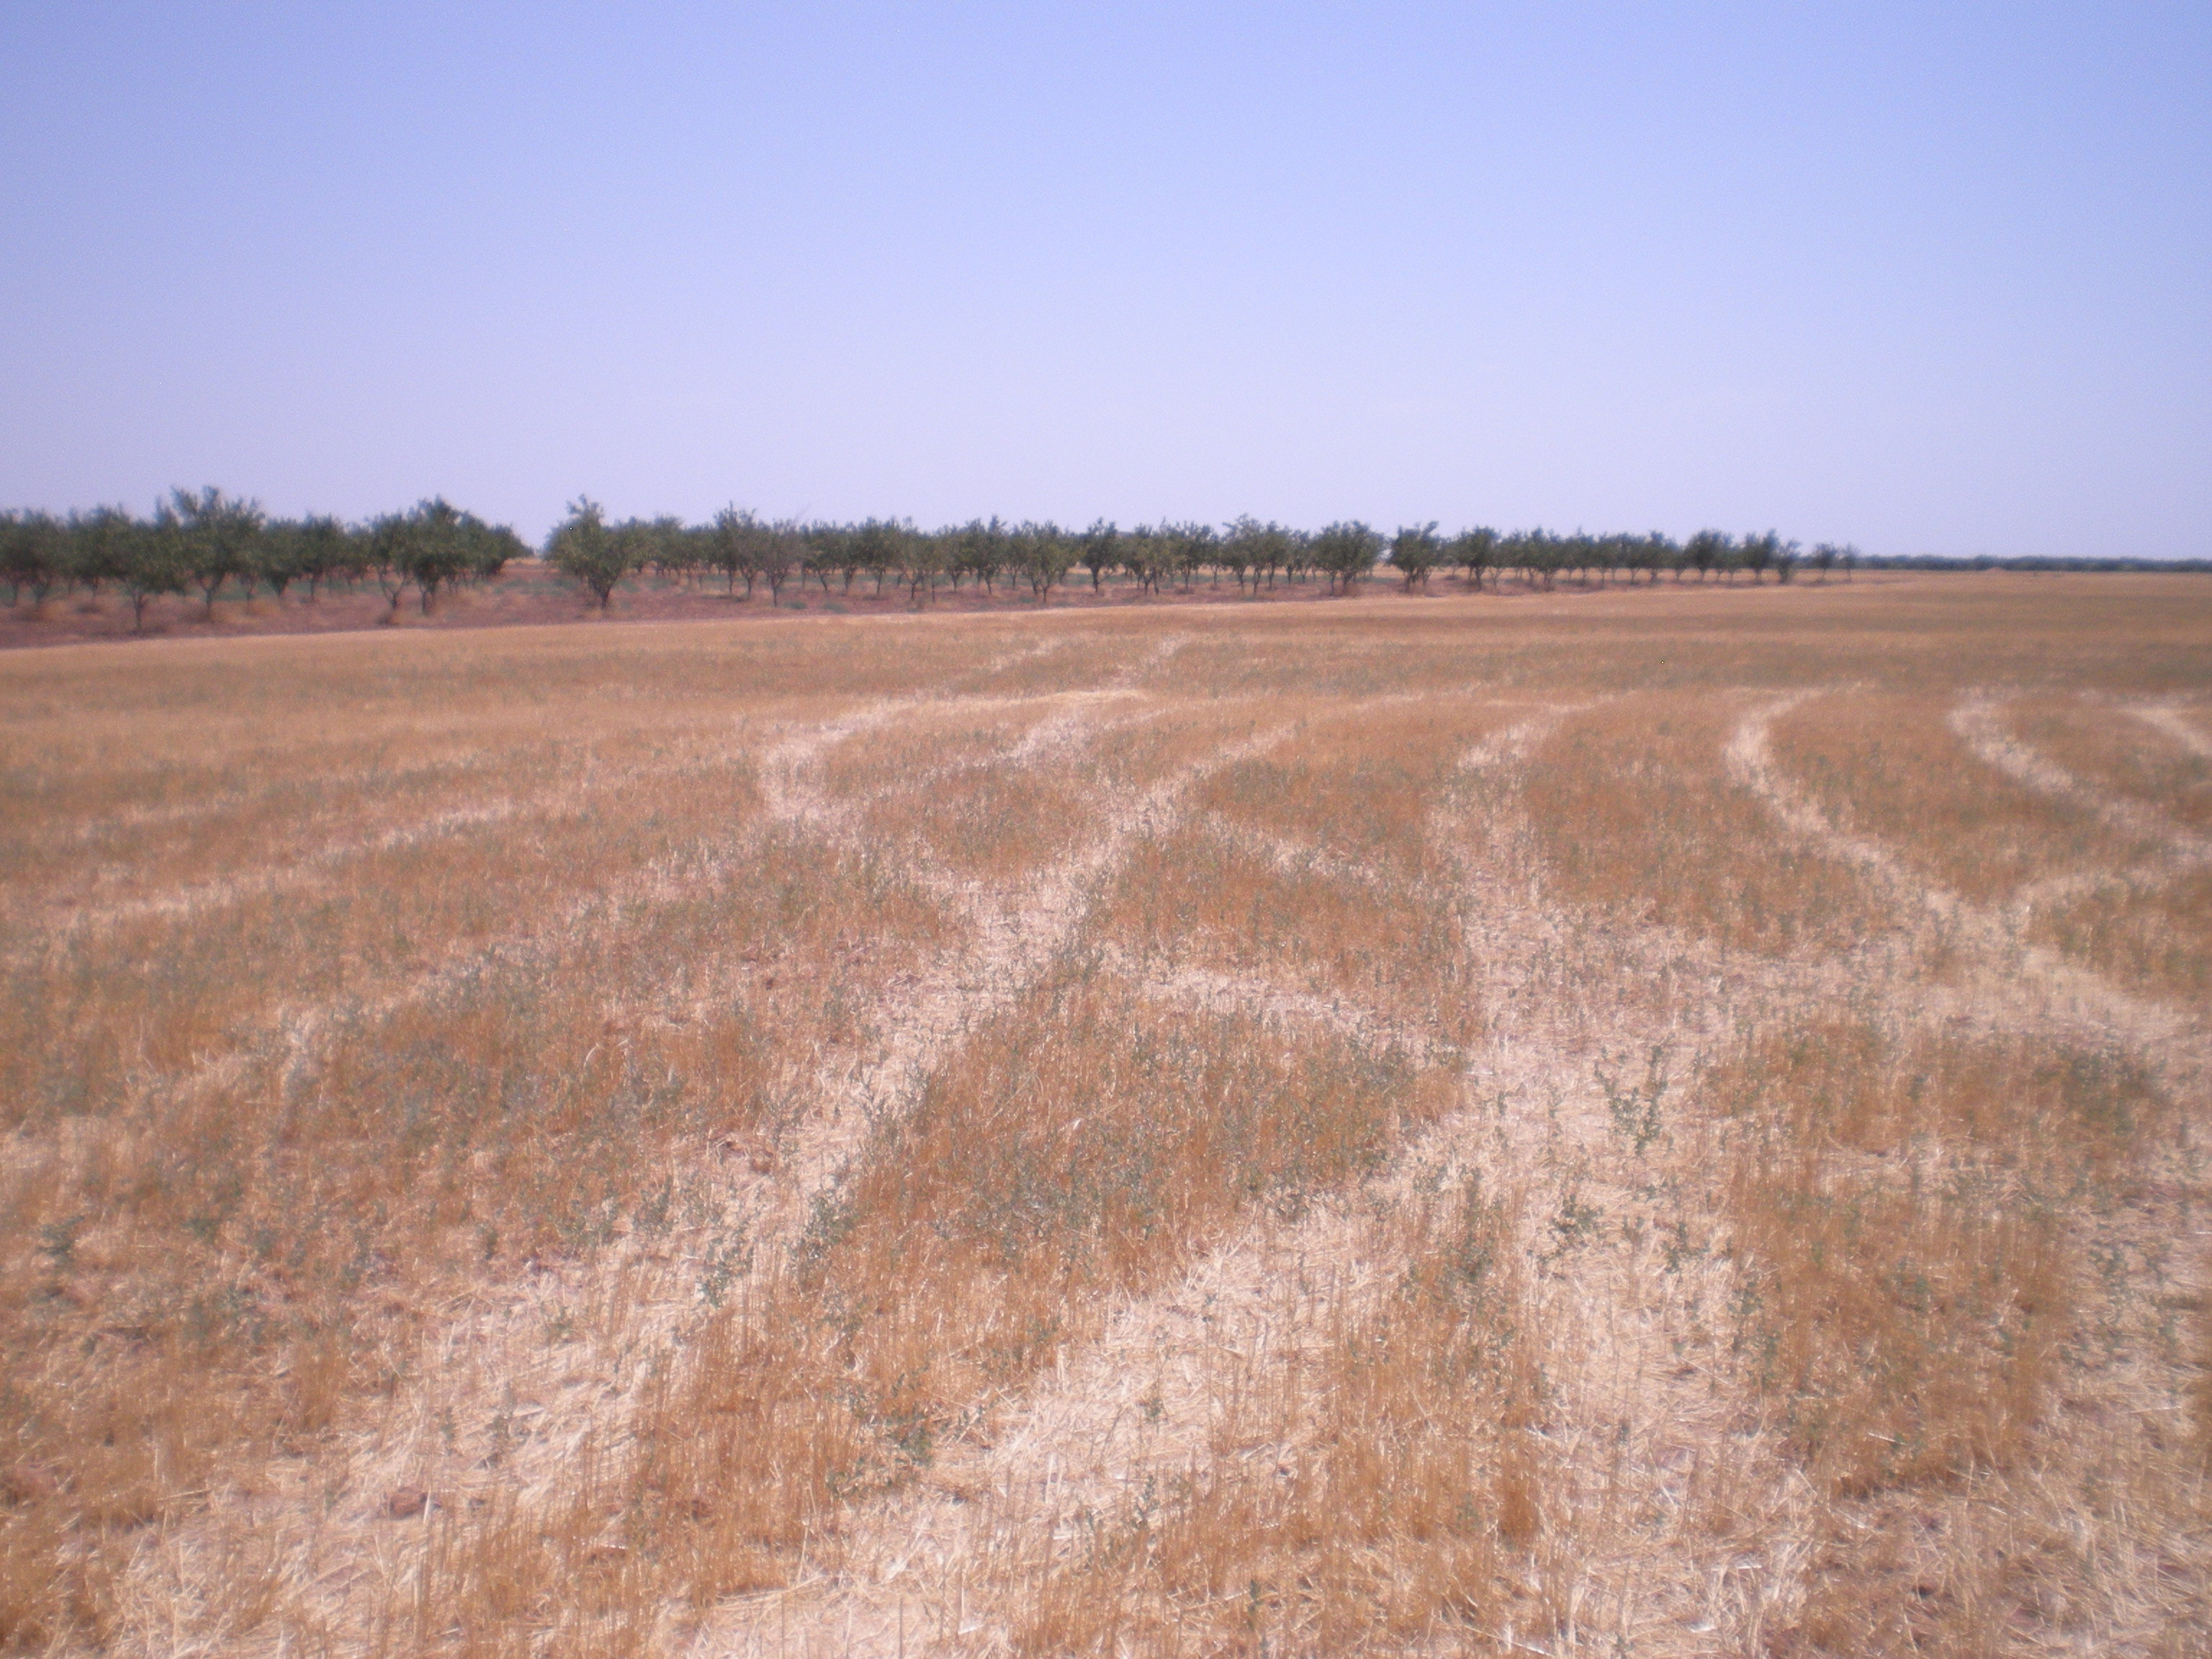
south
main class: Cropland
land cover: Barley
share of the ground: < 10 %
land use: Agriculture (excluding fallow land and kitchen gardens)
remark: Harvested field
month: July
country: ES
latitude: 39.3953
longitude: -3.2908
